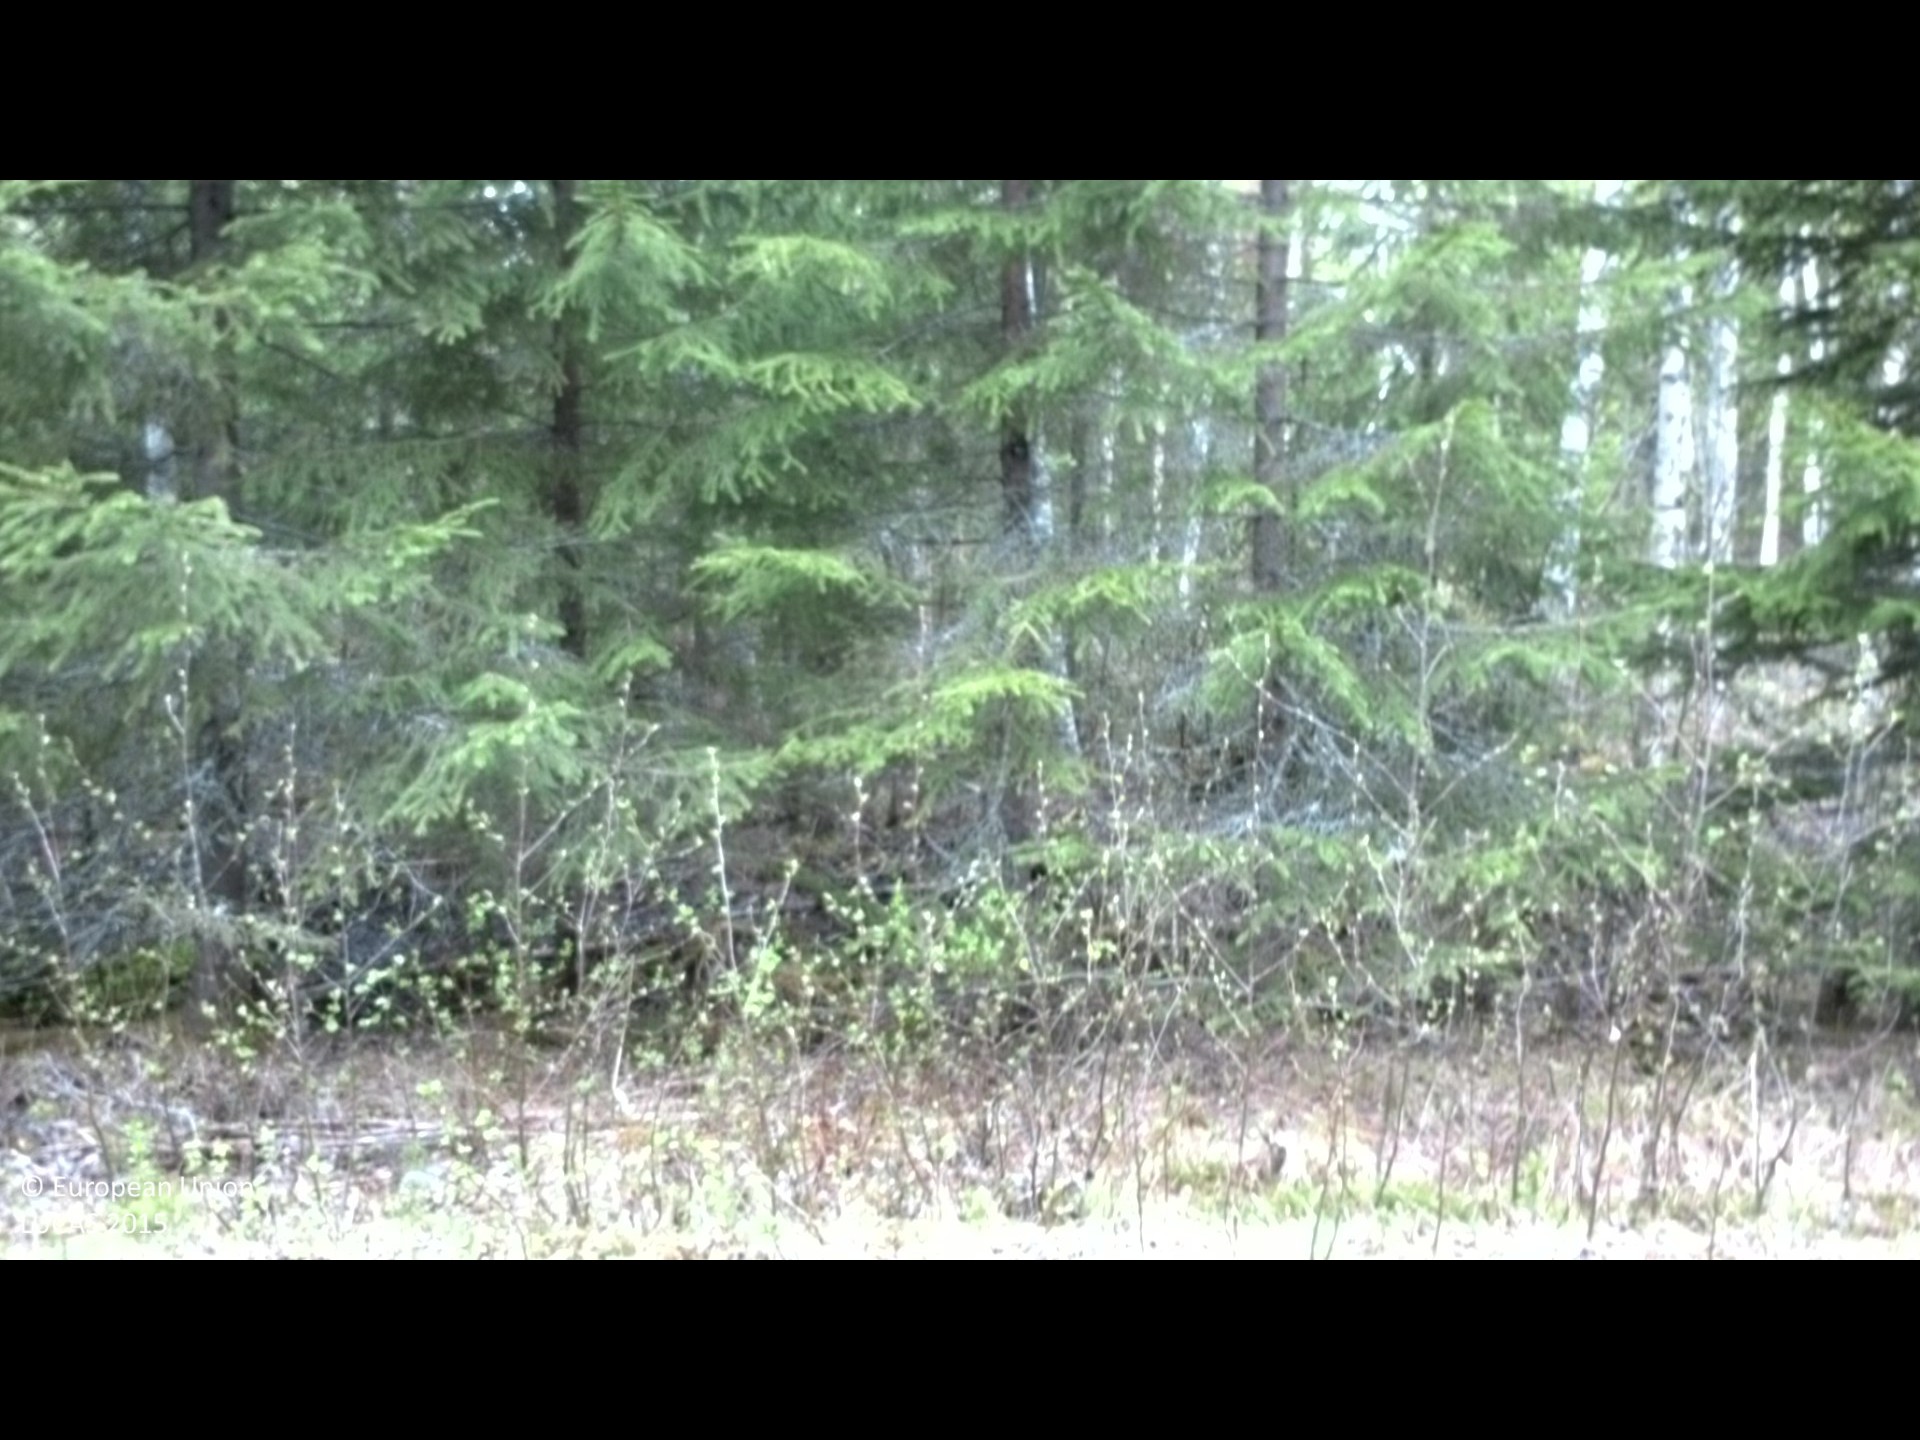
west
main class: Woodland
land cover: Spruce dominated coniferous woodland
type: boreal forest
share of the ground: > 75 %
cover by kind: coniferous forest trees 90 %, shrubs 10 %
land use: Forestry
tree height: > 5 m
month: May
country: SE
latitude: 63.0846
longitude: 17.3622
